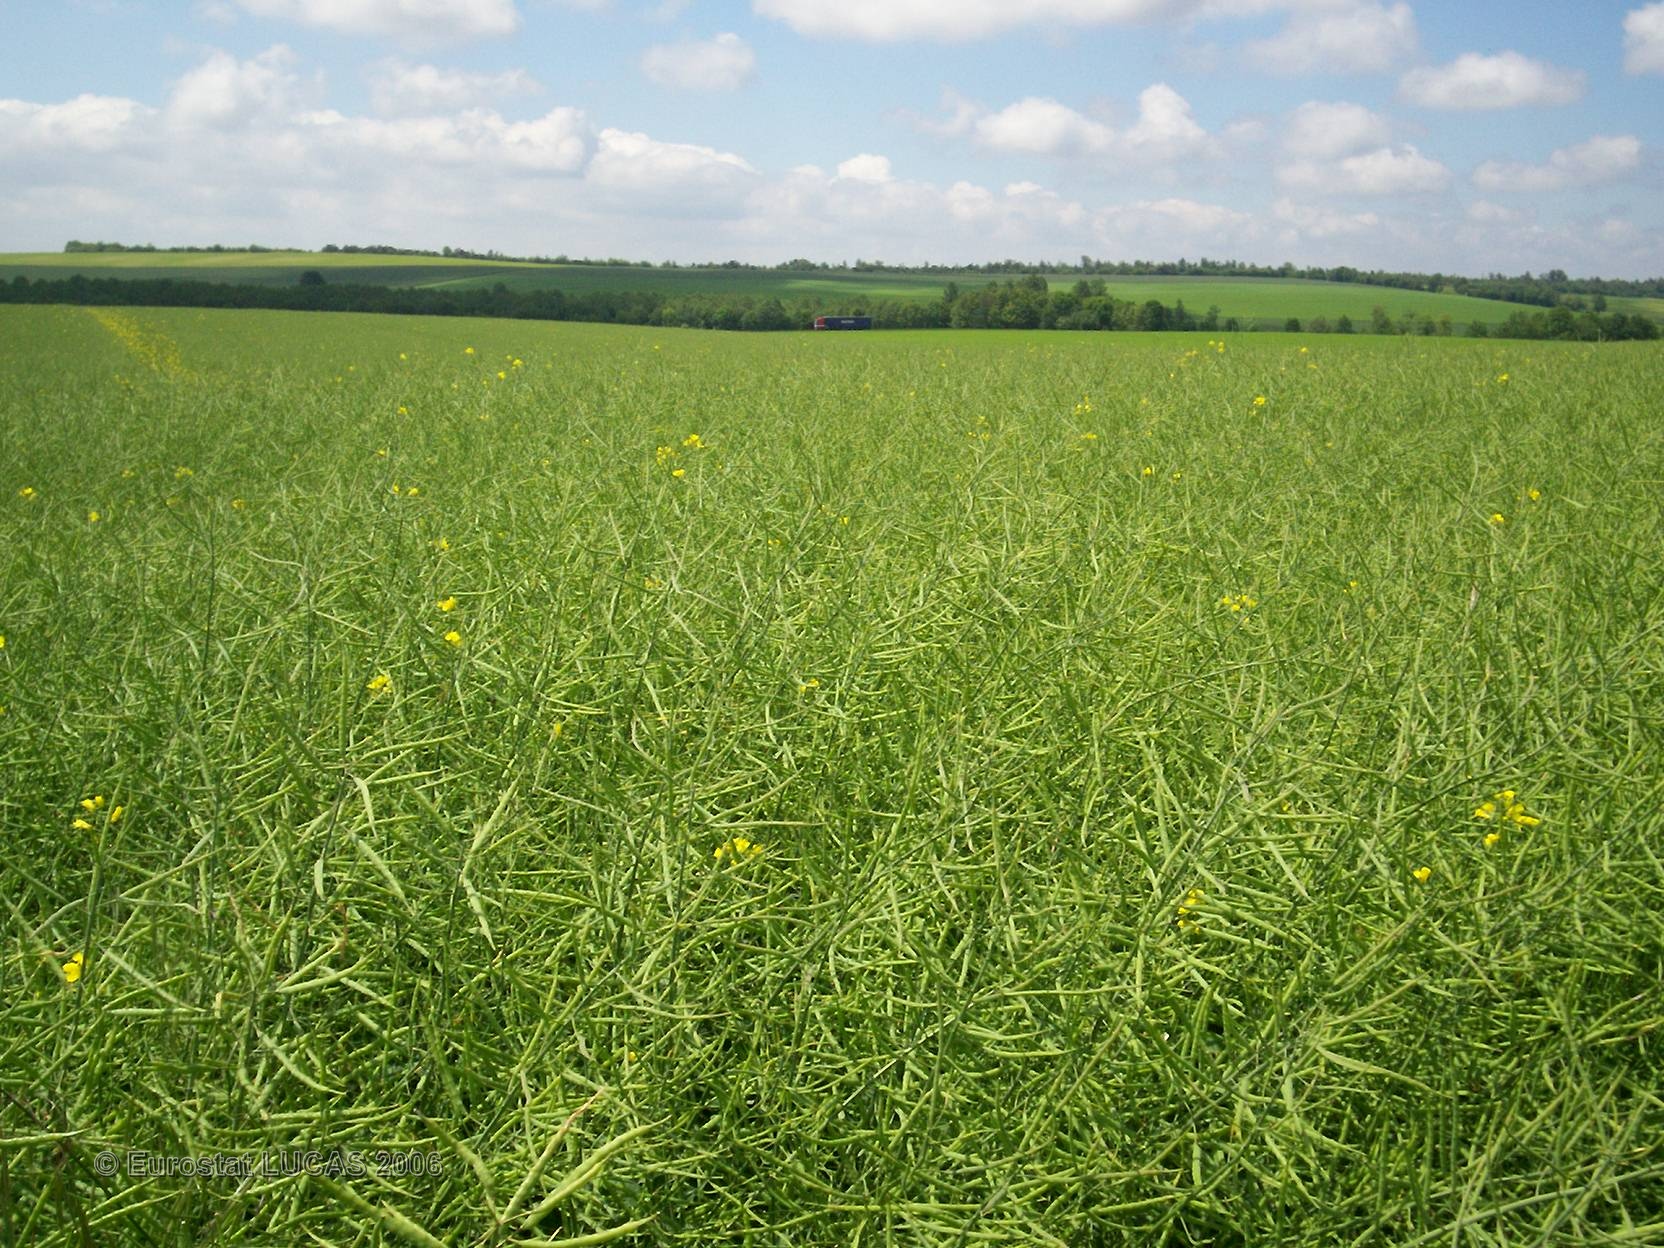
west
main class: Cropland
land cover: Rape and turnip rape
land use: Agriculture (excluding fallow land and kitchen gardens)
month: June
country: FR
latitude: 48.6234
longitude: 4.4210
